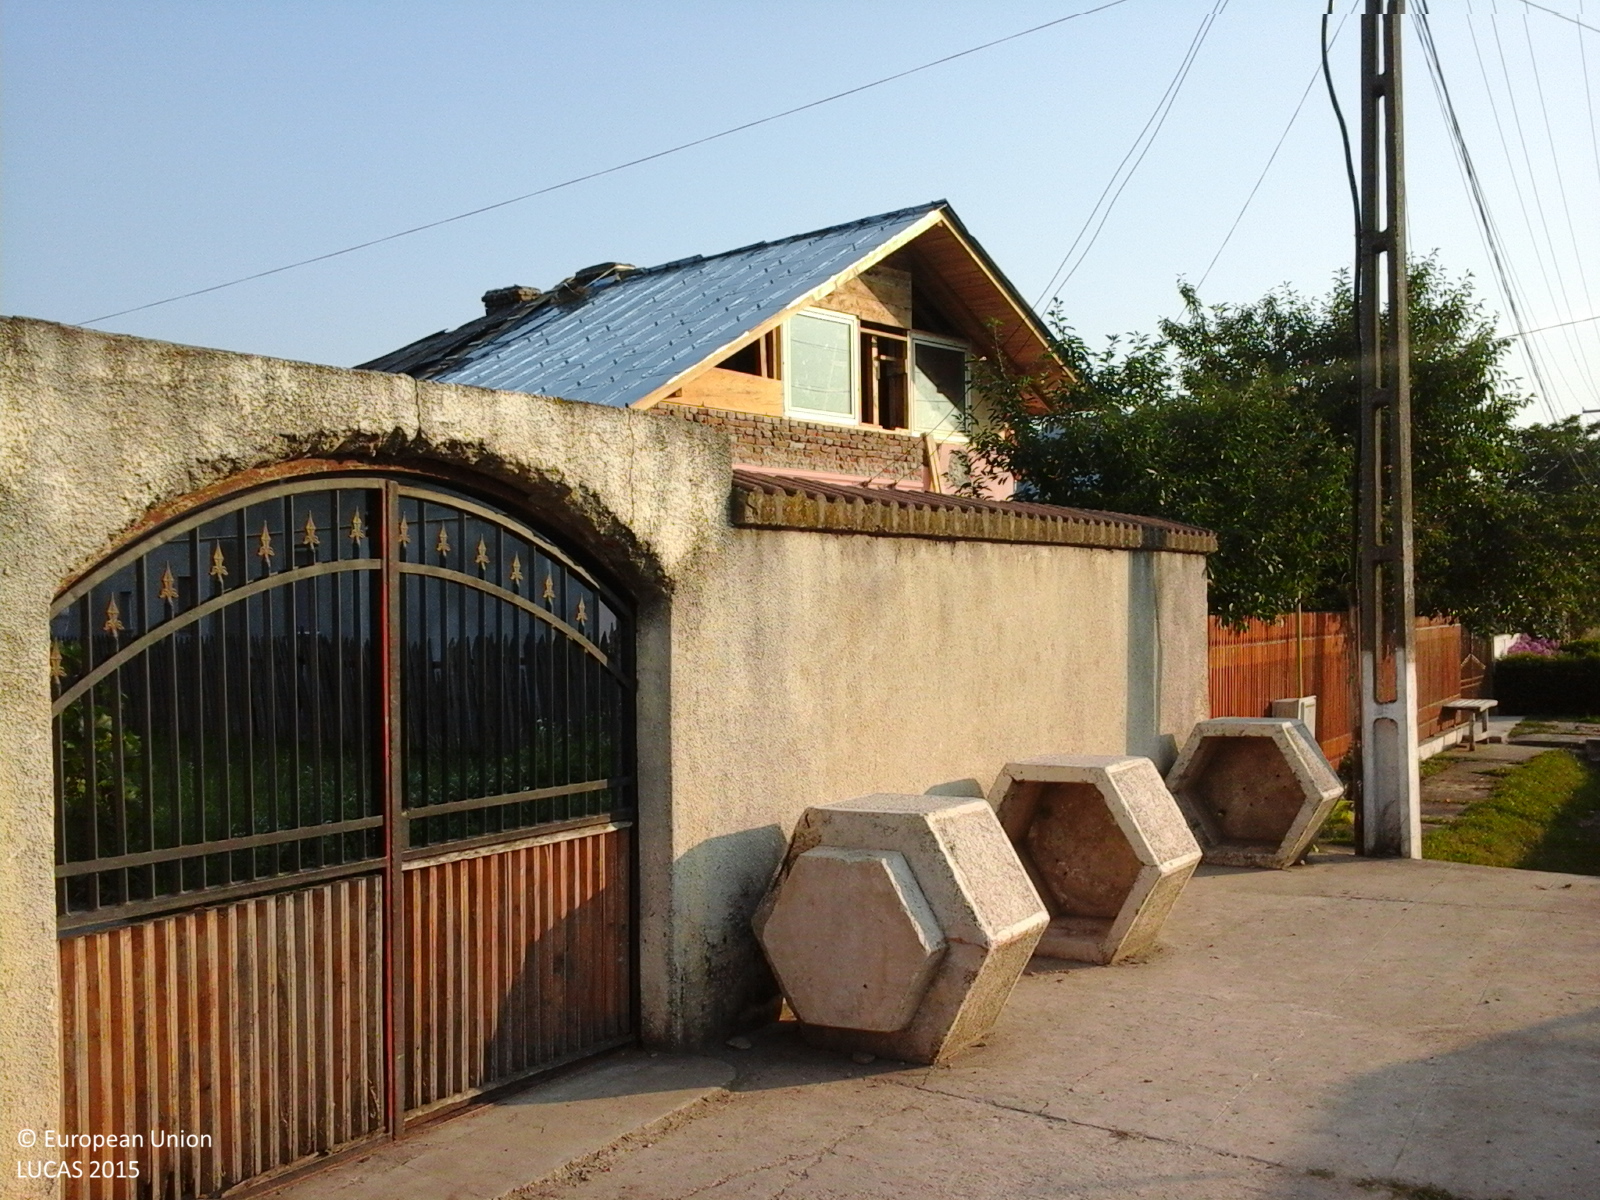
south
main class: Cropland
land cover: Maize
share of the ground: > 75 %
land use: Agriculture (excluding fallow land and kitchen gardens)
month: July
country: RO
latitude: 44.8599
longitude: 25.6517
